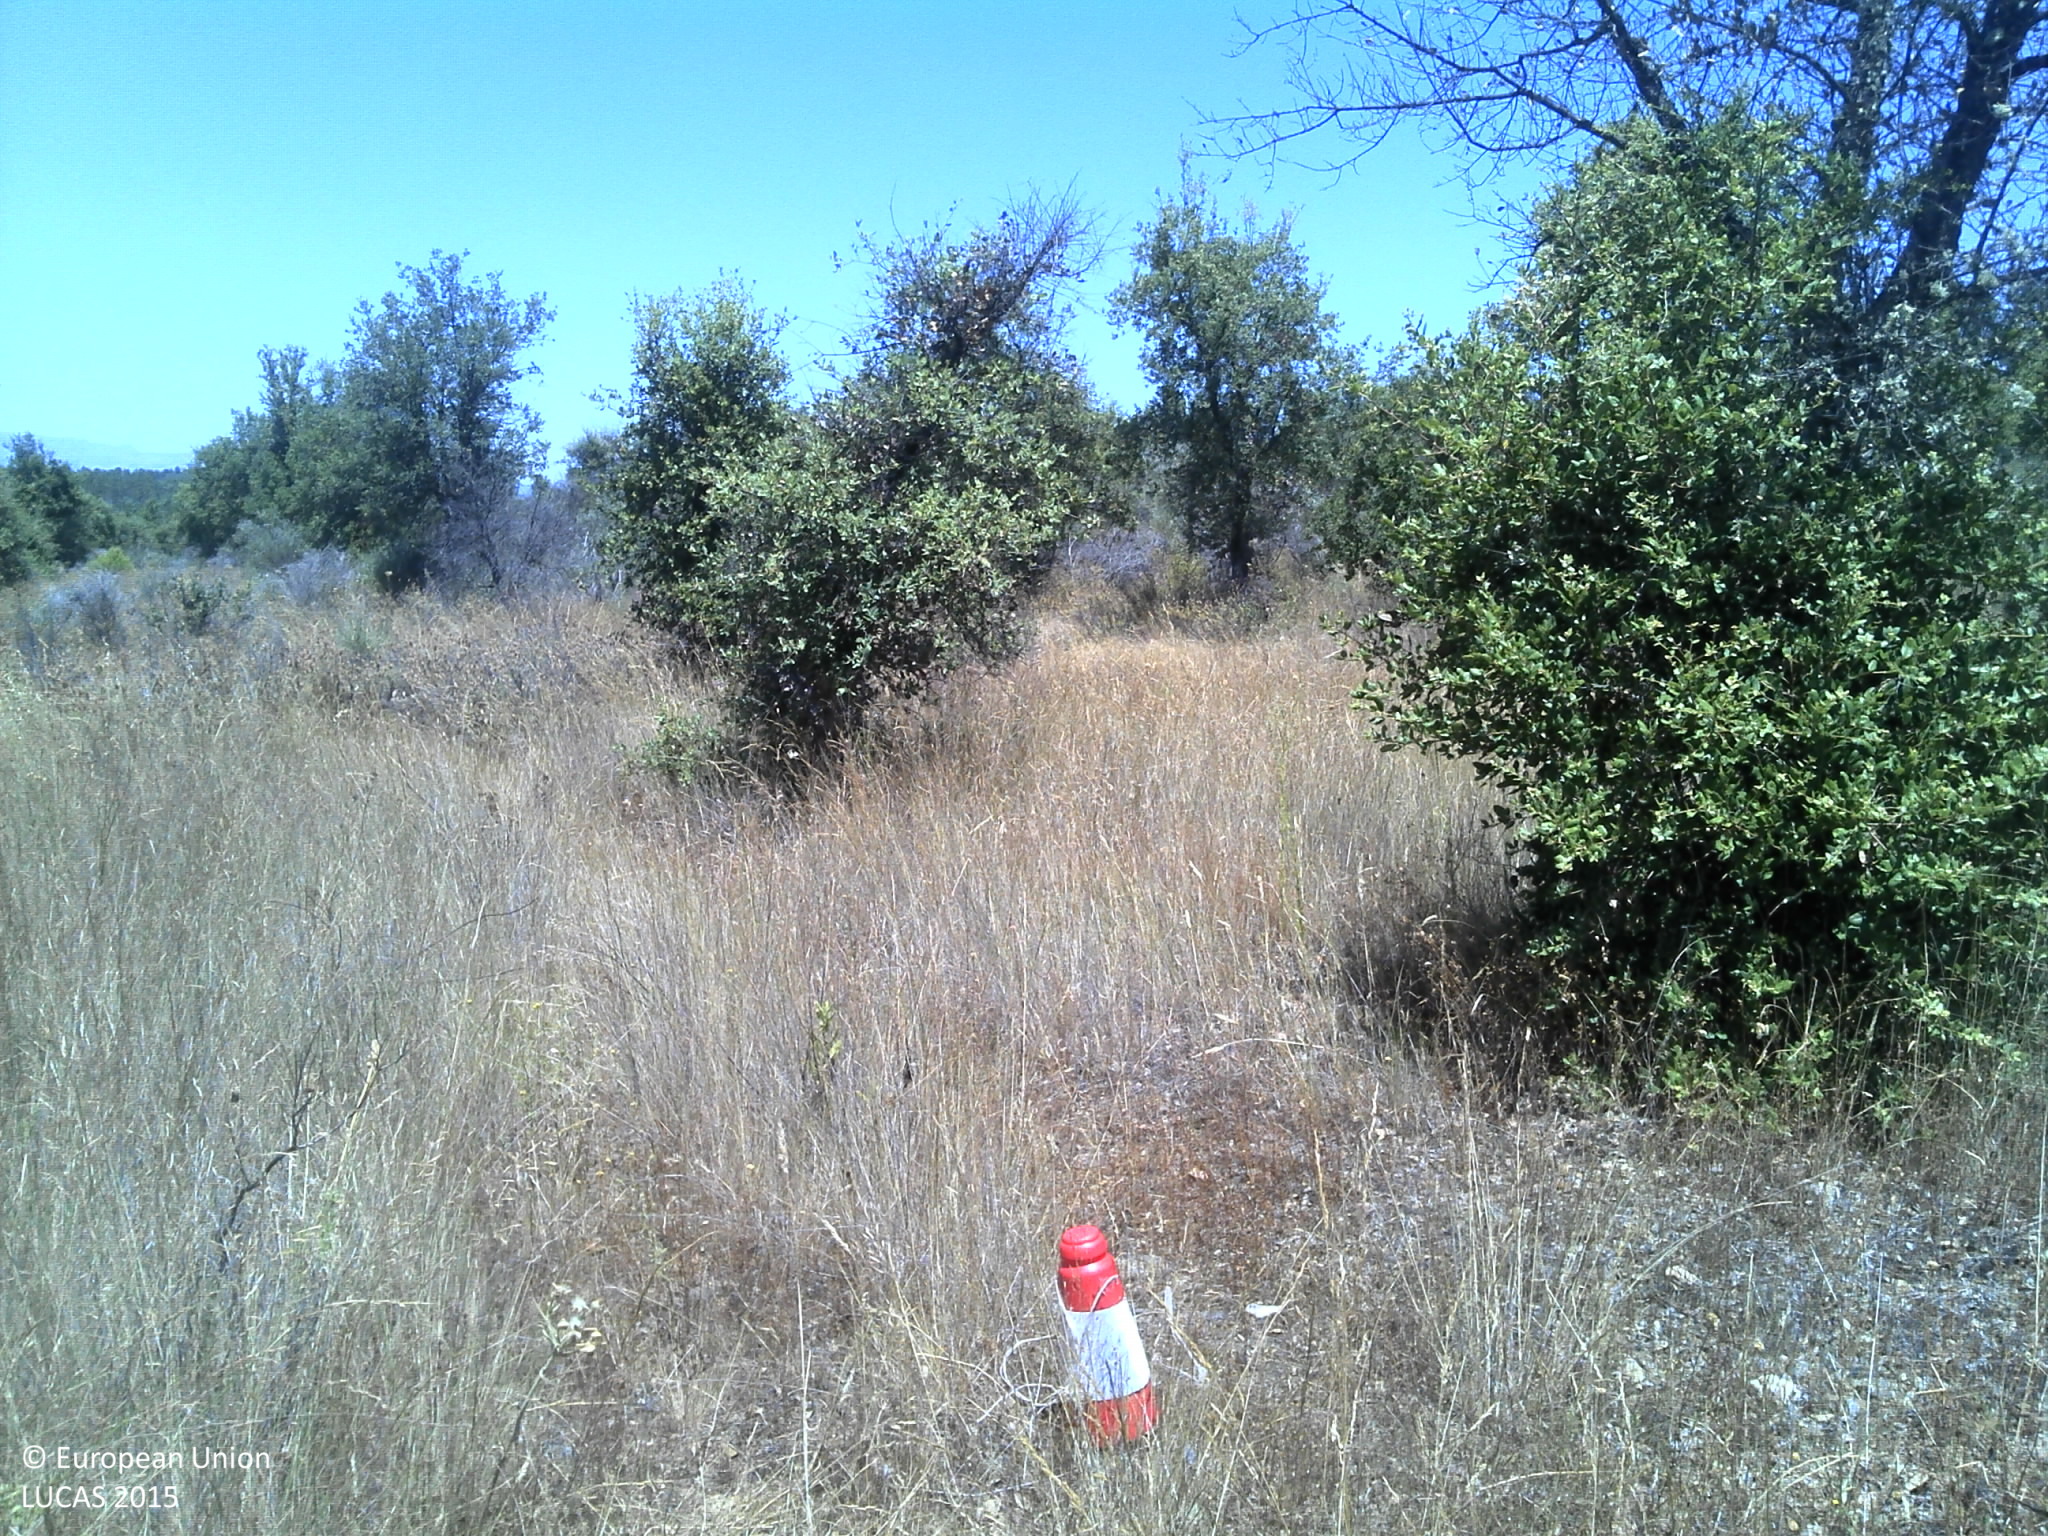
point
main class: Woodland
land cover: Broadleaved woodland
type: broadleaved evergreen forest
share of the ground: 25 - 50 %
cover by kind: broadleaved forest trees 45 %, herbaceous plants 20 %, unconsolidated bare surface 20 %, shrubs 15 %
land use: Forestry
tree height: < 5 m
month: June
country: PT
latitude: 40.0903
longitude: -7.2572
